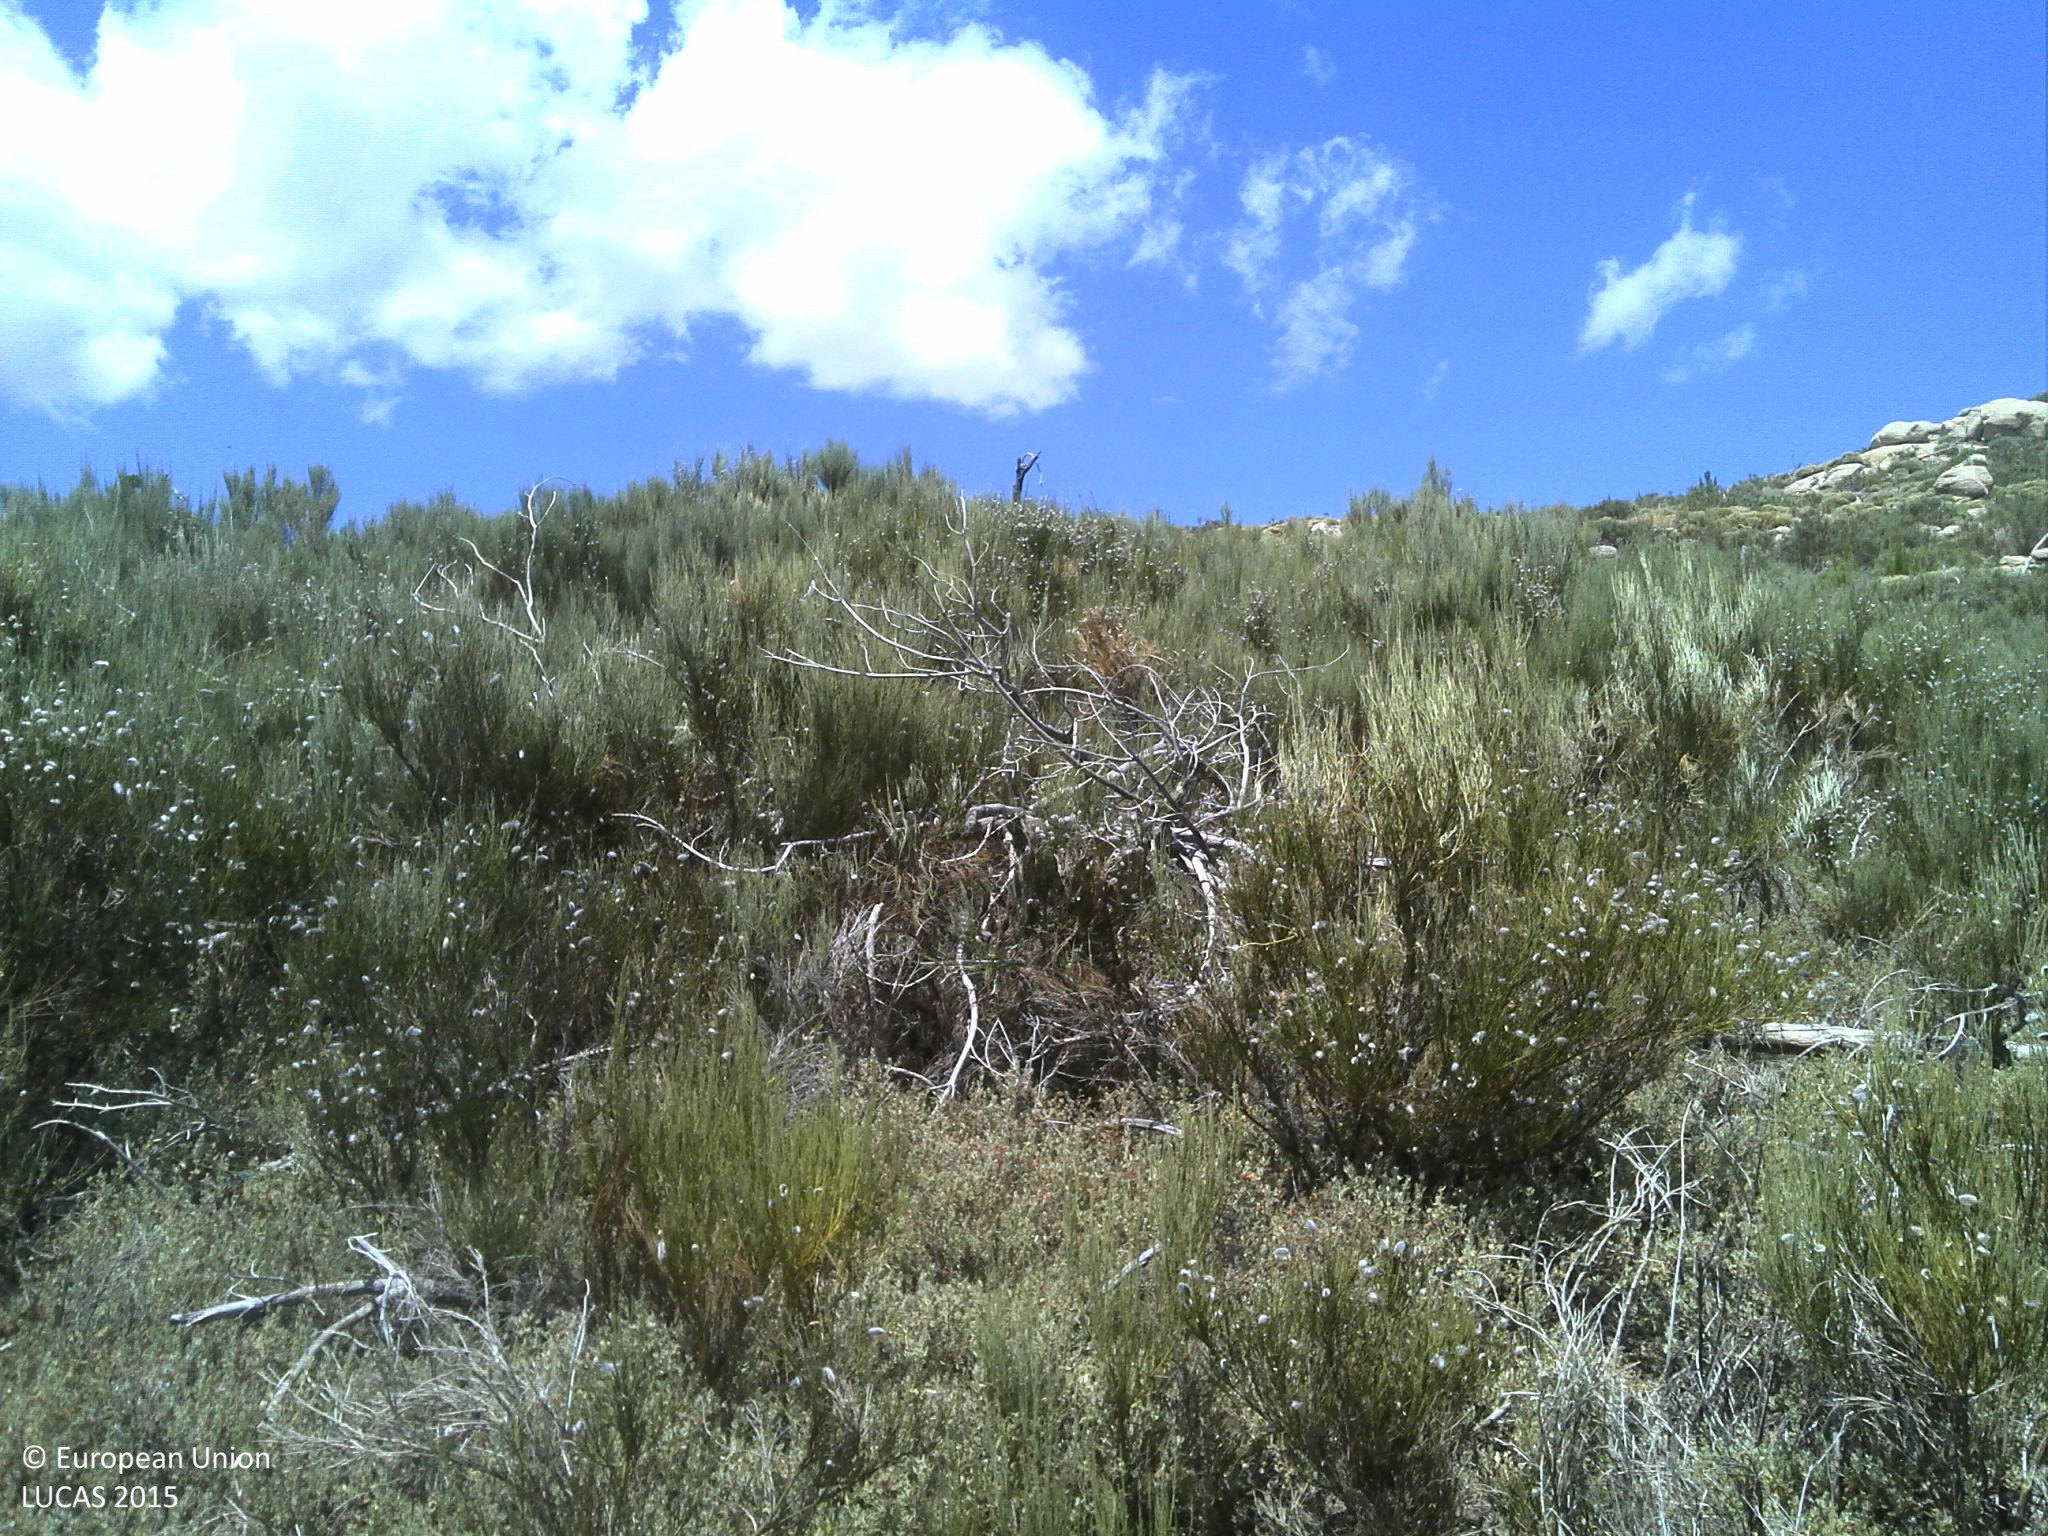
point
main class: Shrubland
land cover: Shrubland without tree cover
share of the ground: > 75 %
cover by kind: shrubs 75 %, consolidated bare surface 20 %, herbaceous plants 5 %
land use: Semi-natural and natural areas not in use
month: July
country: PT
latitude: 40.3559
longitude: -7.5238
